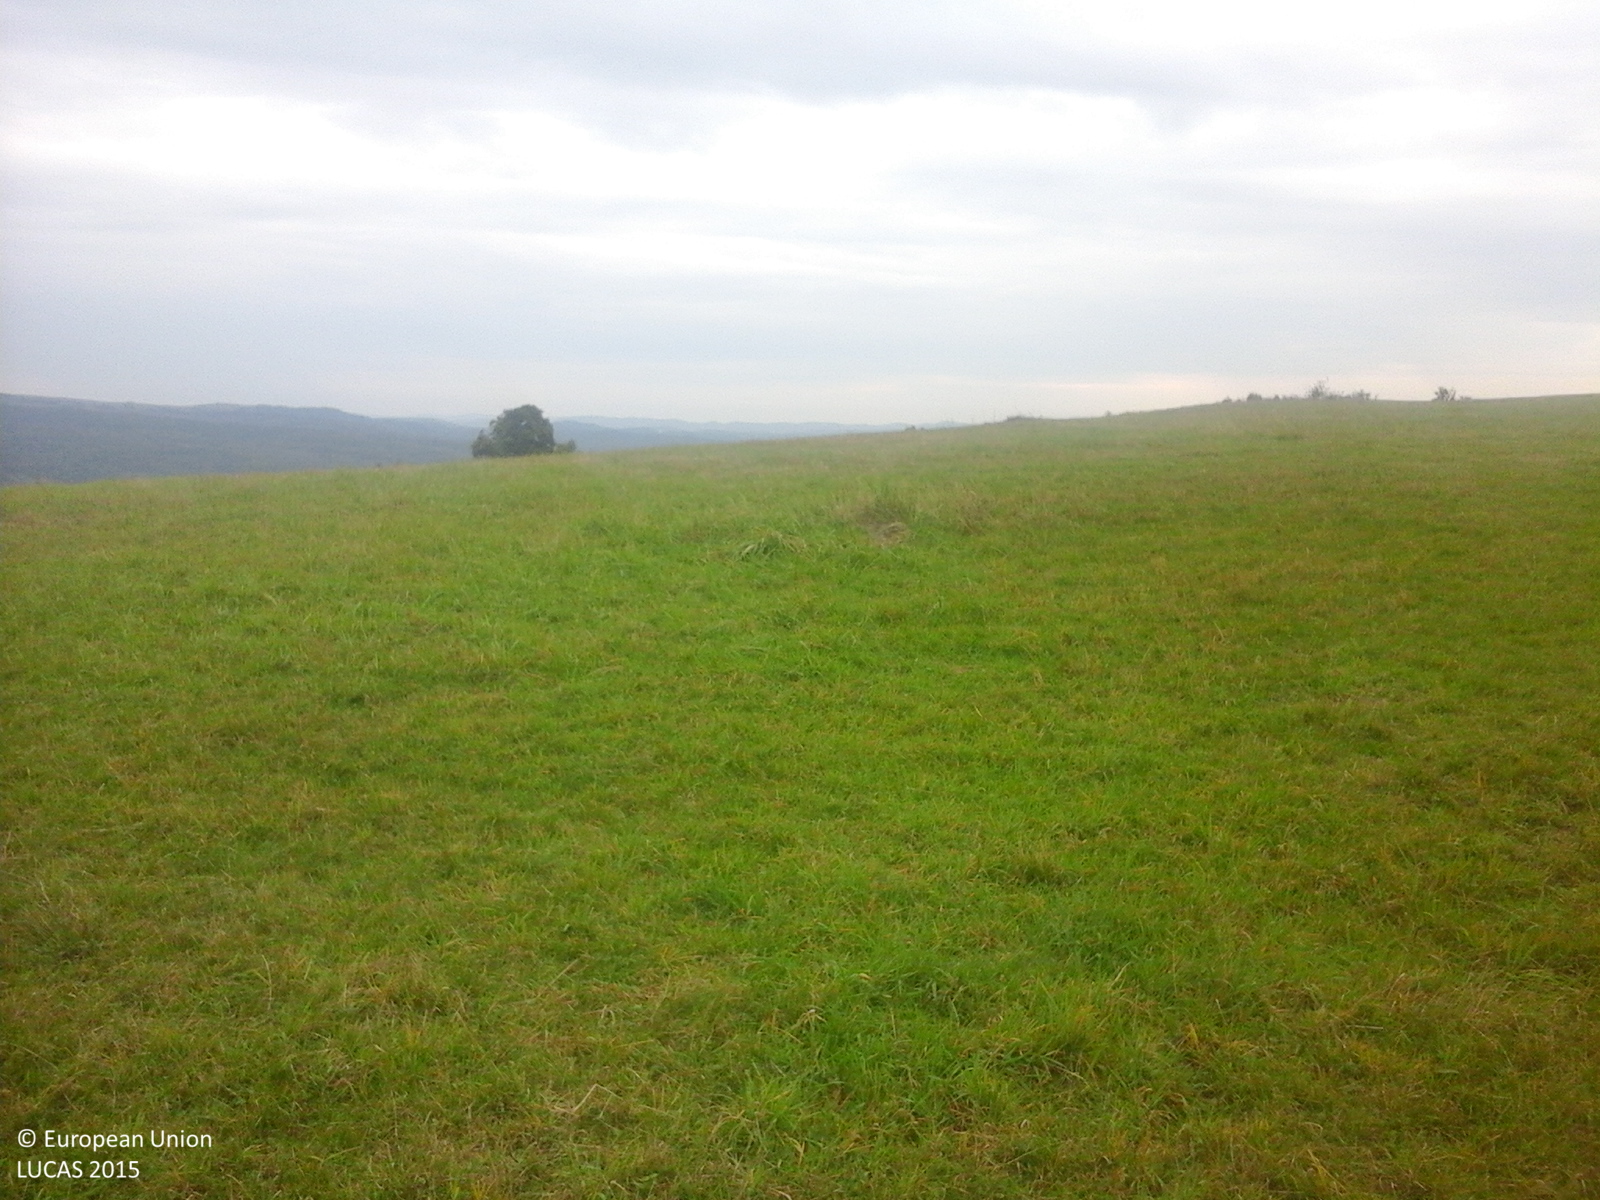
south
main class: Grassland
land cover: Grassland without tree/shrub cover
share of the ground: > 75 %
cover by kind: herbaceous plants 100 %
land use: Agriculture (excluding fallow land and kitchen gardens)
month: October
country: RO
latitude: 46.5836
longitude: 25.0148
